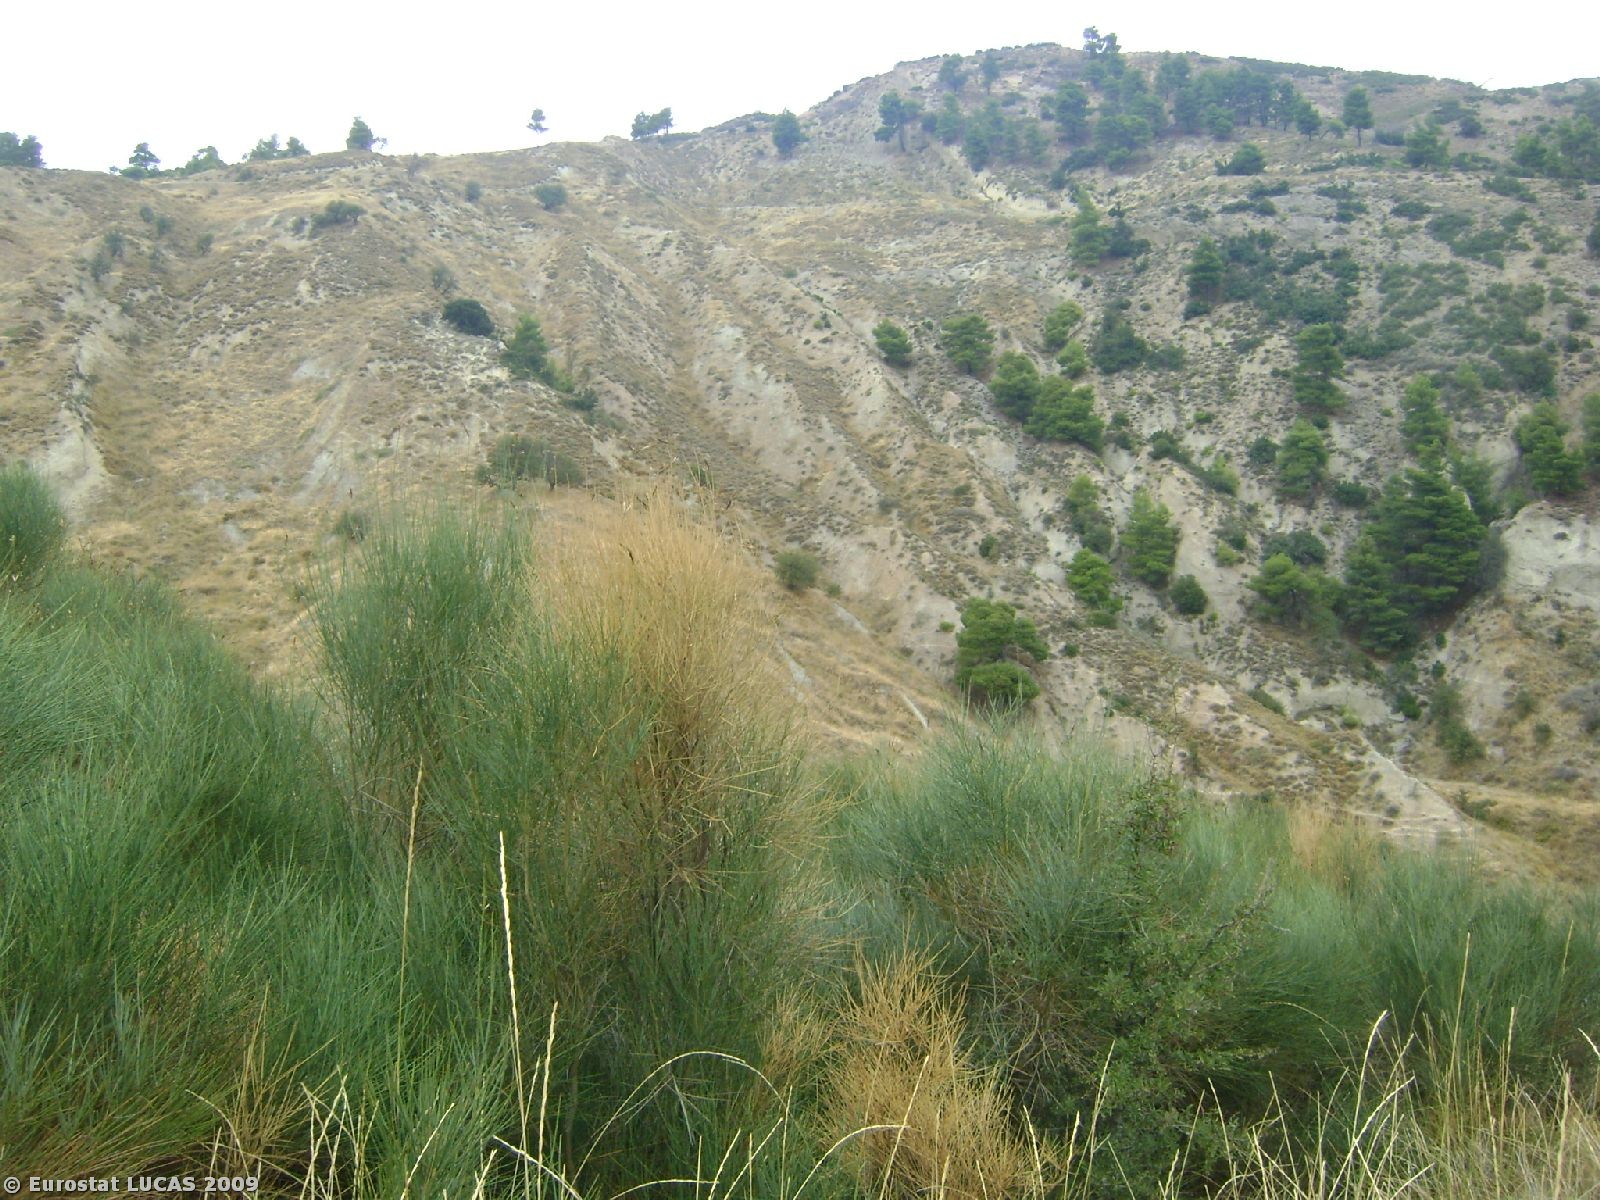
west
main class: Shrubland
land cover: Shrubland with sparse tree cover
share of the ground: > 75 %
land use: Unused
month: October
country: GR
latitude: 38.1181
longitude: 22.2998
